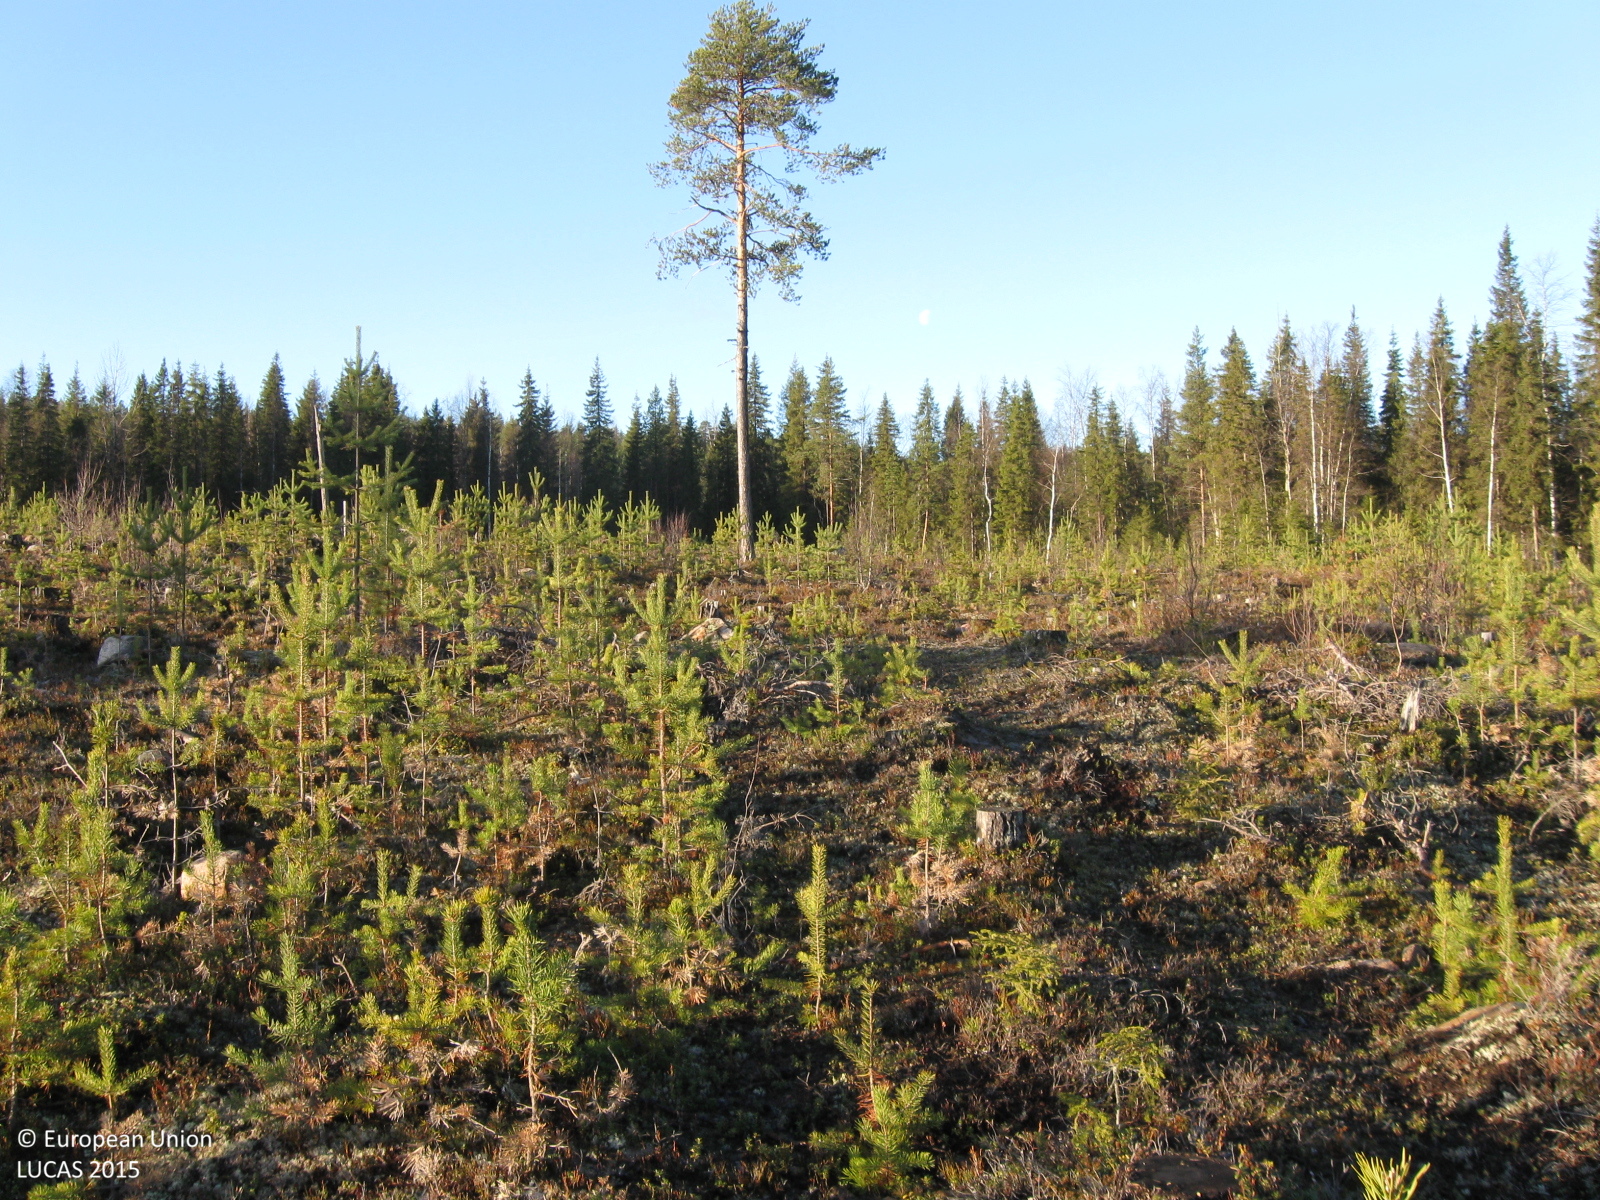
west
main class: Woodland
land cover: Pine dominated coniferous woodland
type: boreal forest
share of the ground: 25 - 50 %
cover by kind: coniferous forest trees 30 %, shrubs 20 %, herbaceous plants 10 %, lichens and mosses 10 %, consolidated bare surface 10 %, unconsolidated bare surface 10 %, broadleaved forest trees 5 %
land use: Forestry
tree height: < 5 m
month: November
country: SE
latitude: 66.1134
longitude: 20.7845
